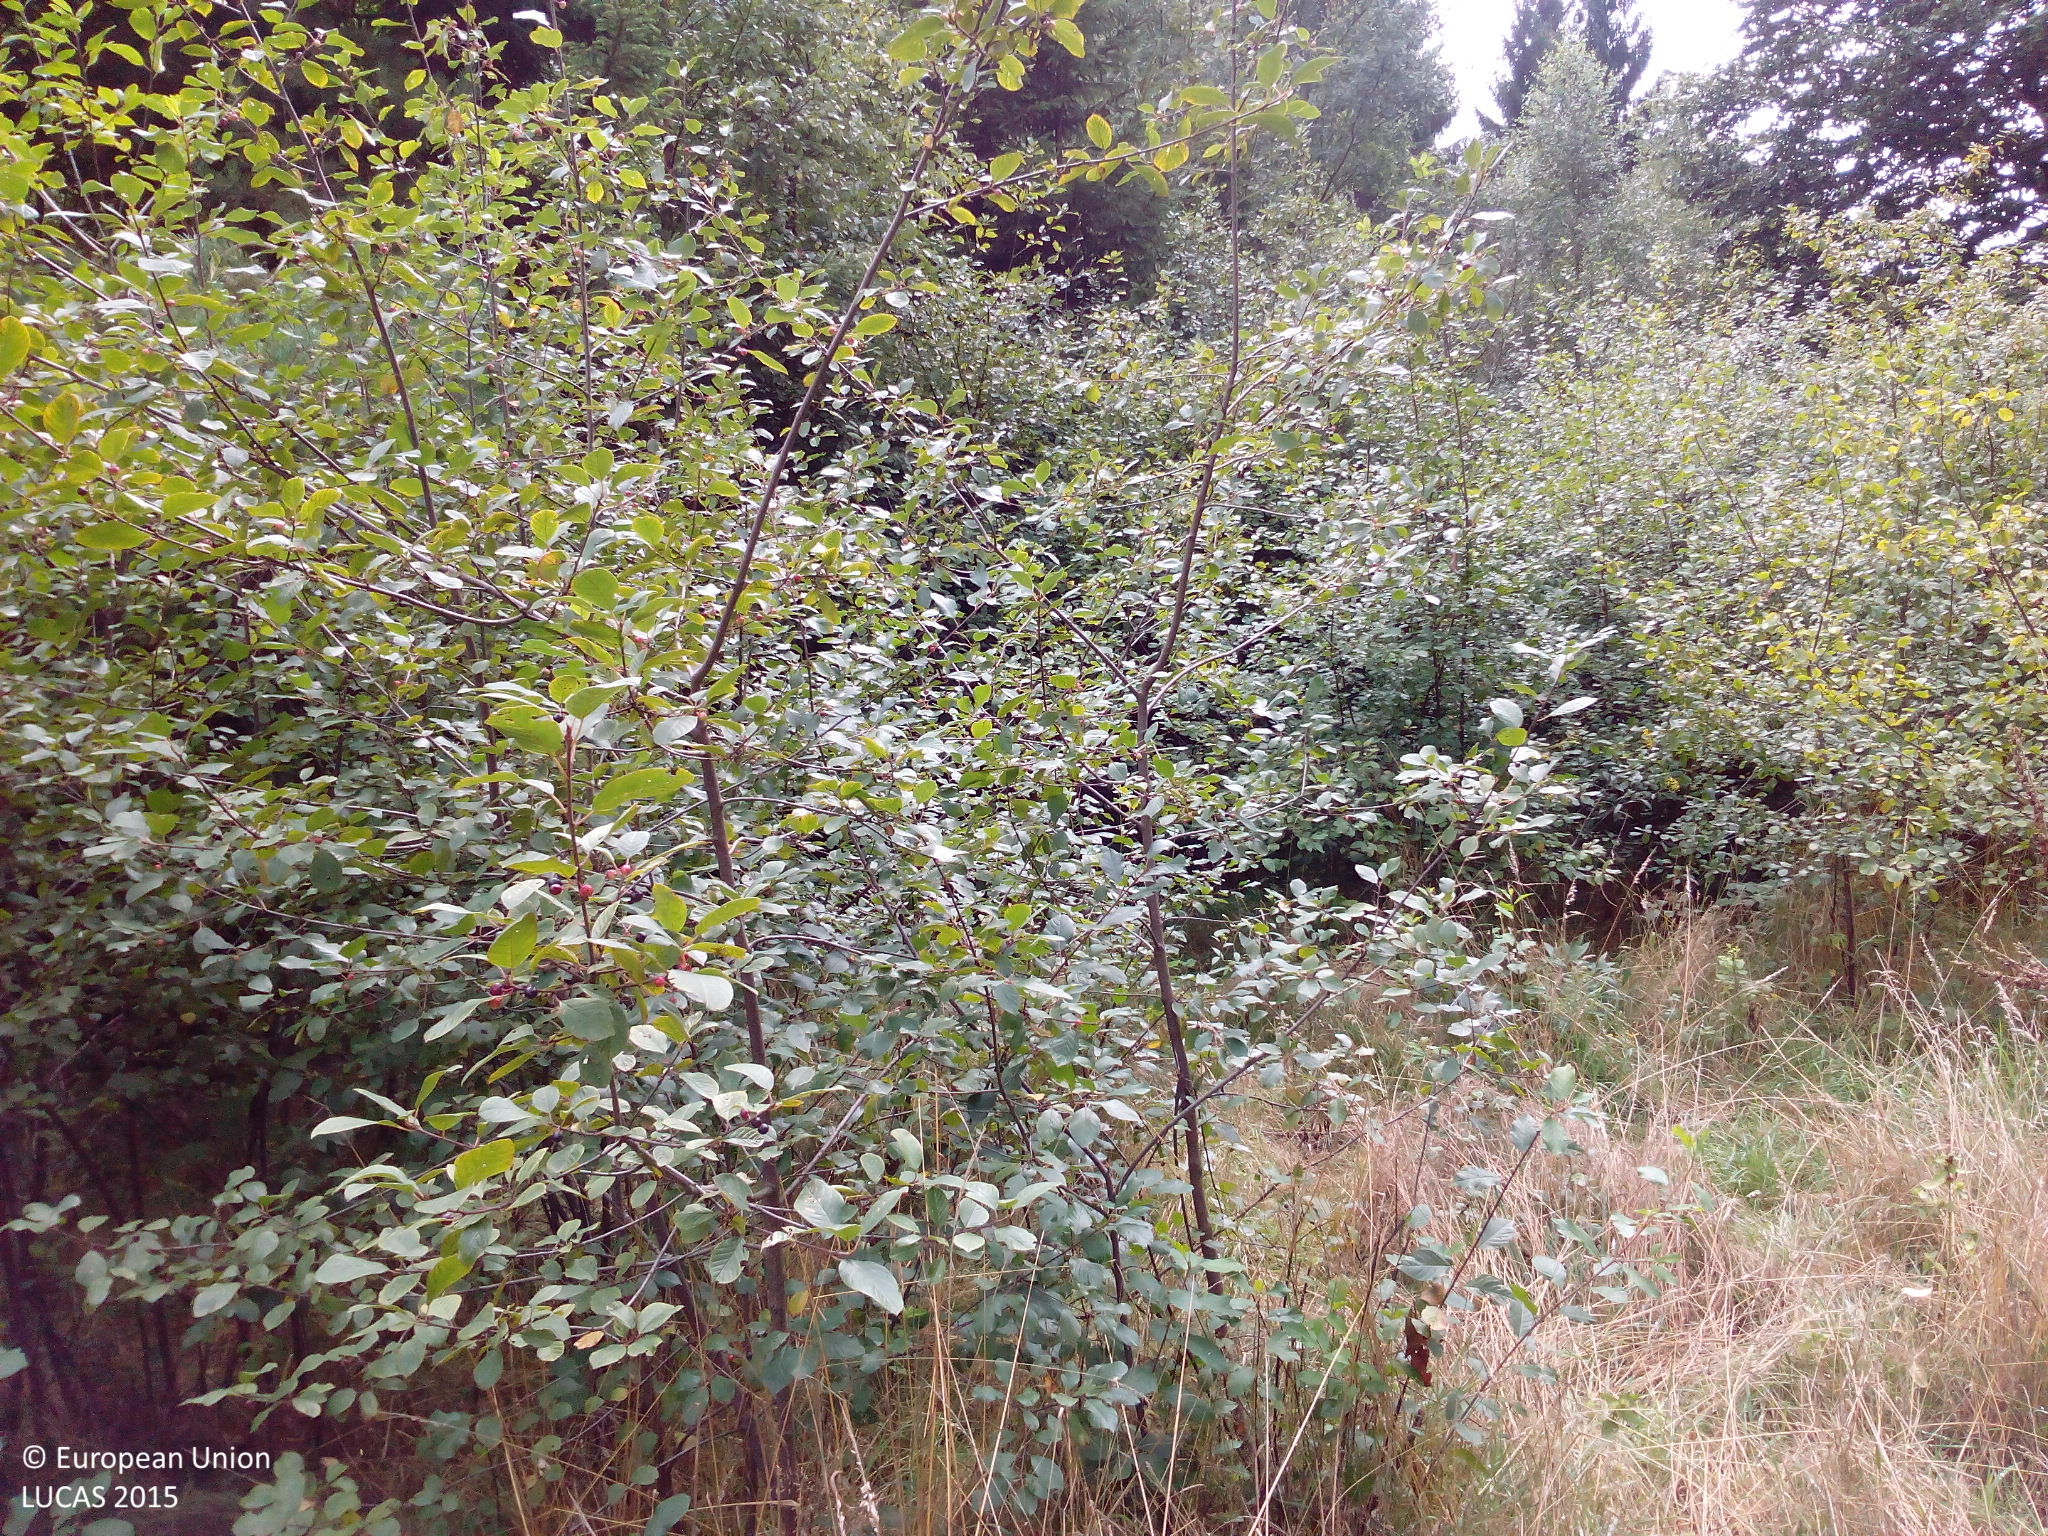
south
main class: Shrubland
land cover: Shrubland with sparse tree cover
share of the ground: > 75 %
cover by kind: shrubs 70 %, herbaceous plants 25 %, broadleaved forest trees 5 %
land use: Forestry
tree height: < 5 m
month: August
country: DE
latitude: 50.0861
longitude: 7.5545
